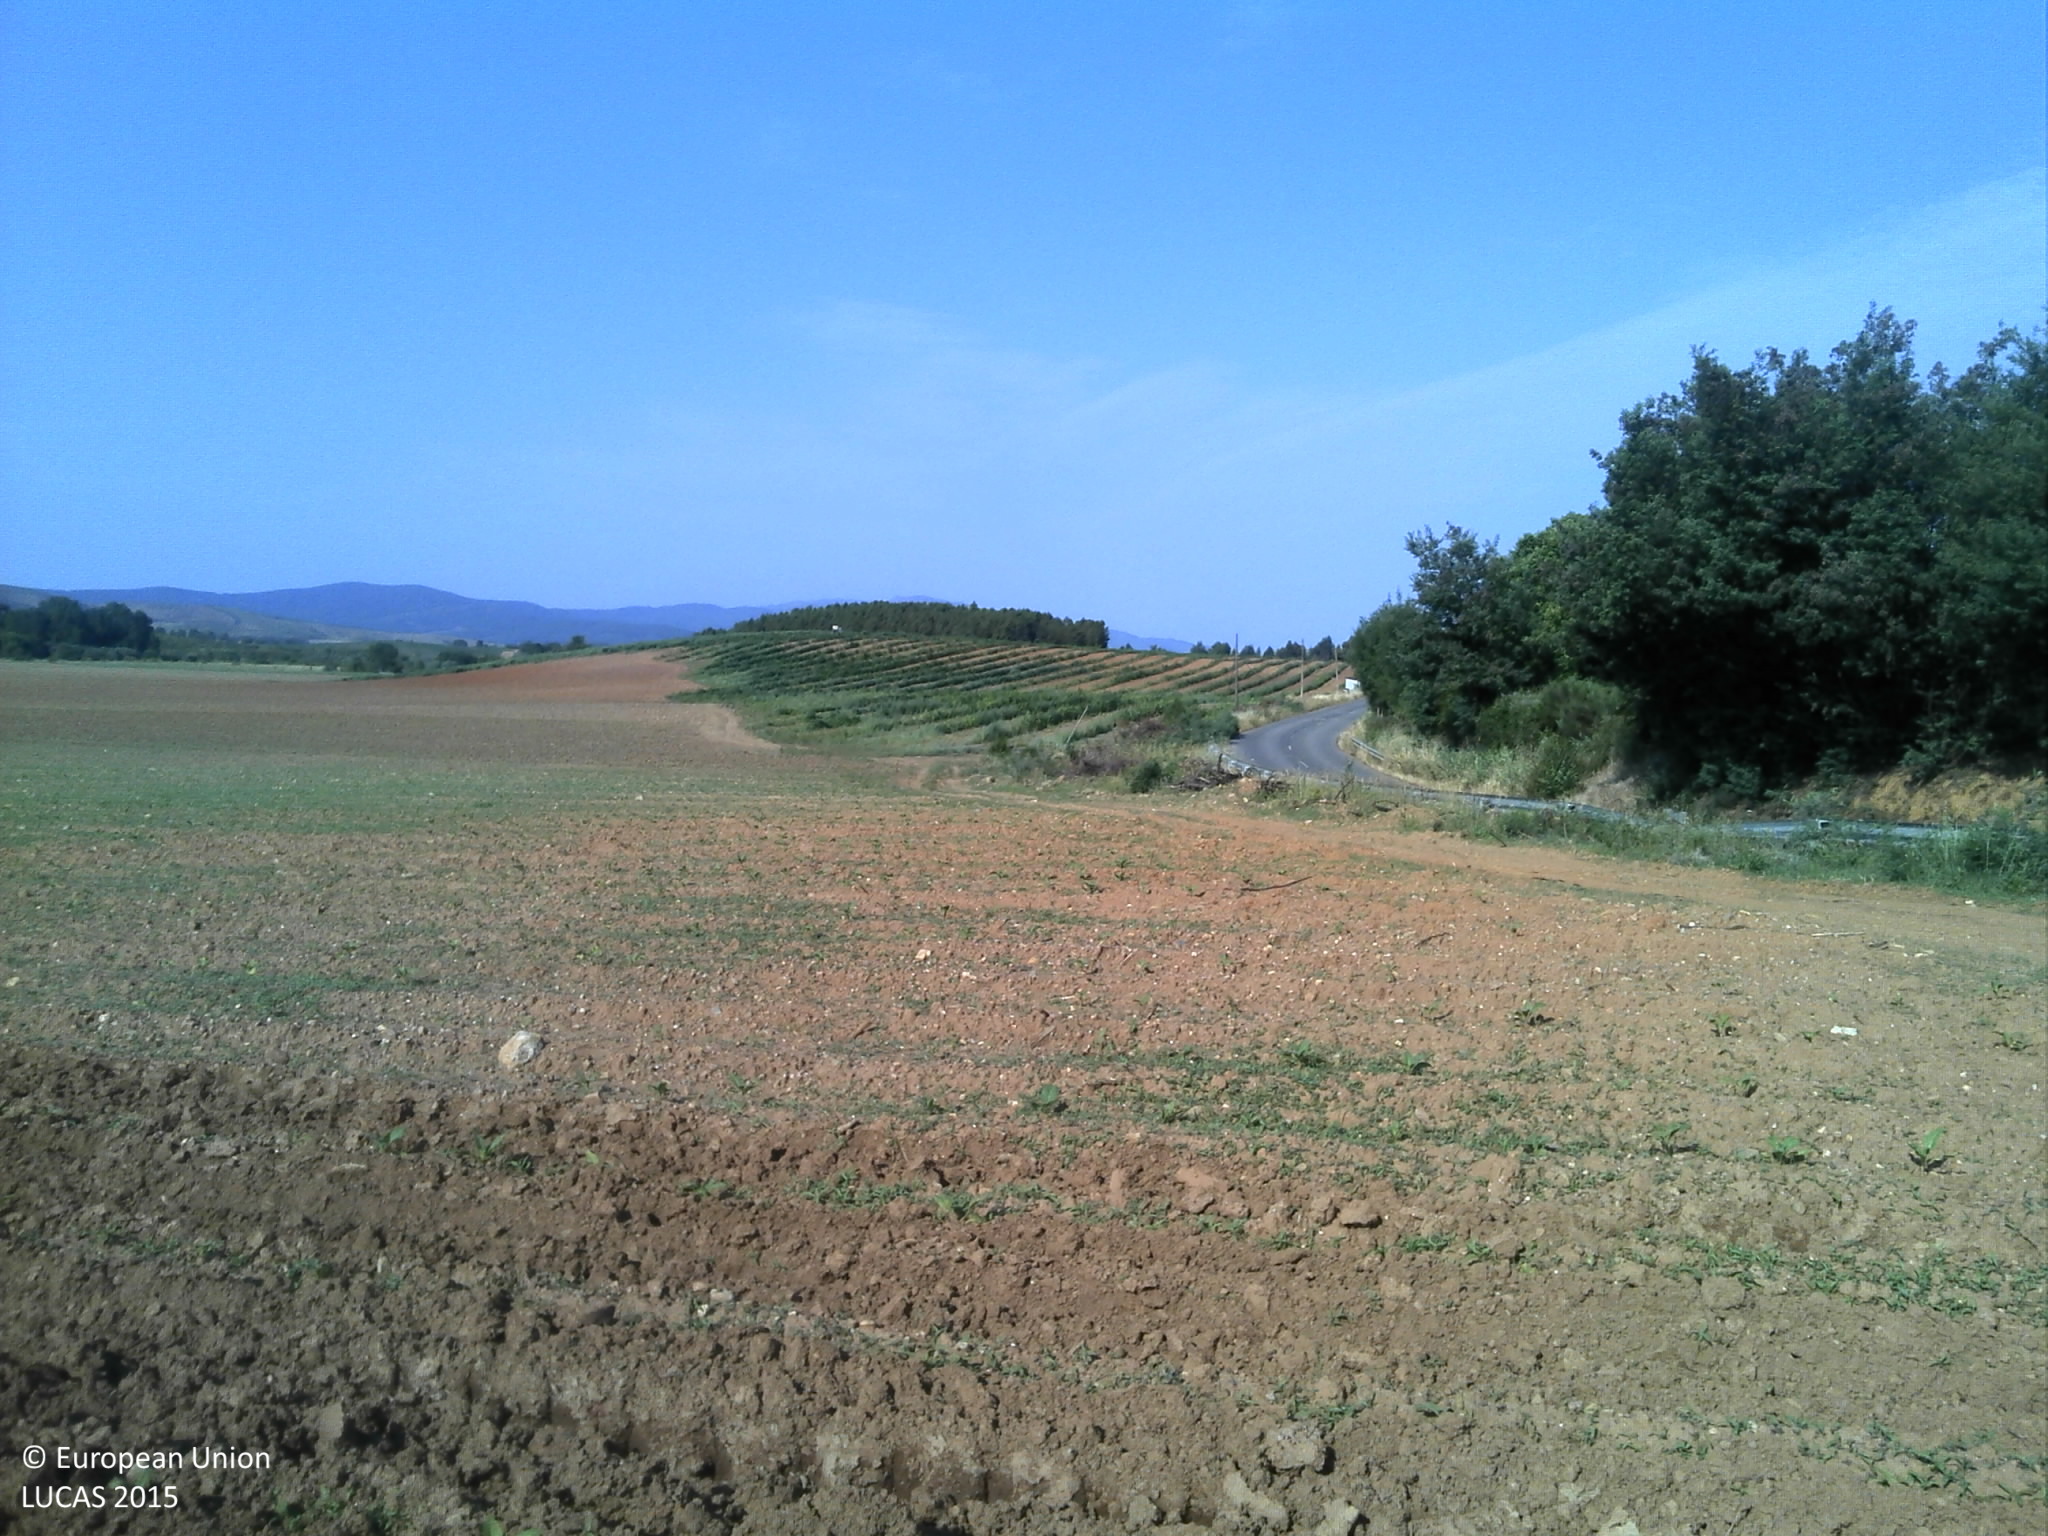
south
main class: Cropland
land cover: Tobacco
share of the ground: < 10 %
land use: Agriculture (excluding fallow land and kitchen gardens)
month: June
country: PT
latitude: 40.2051
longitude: -7.3369
